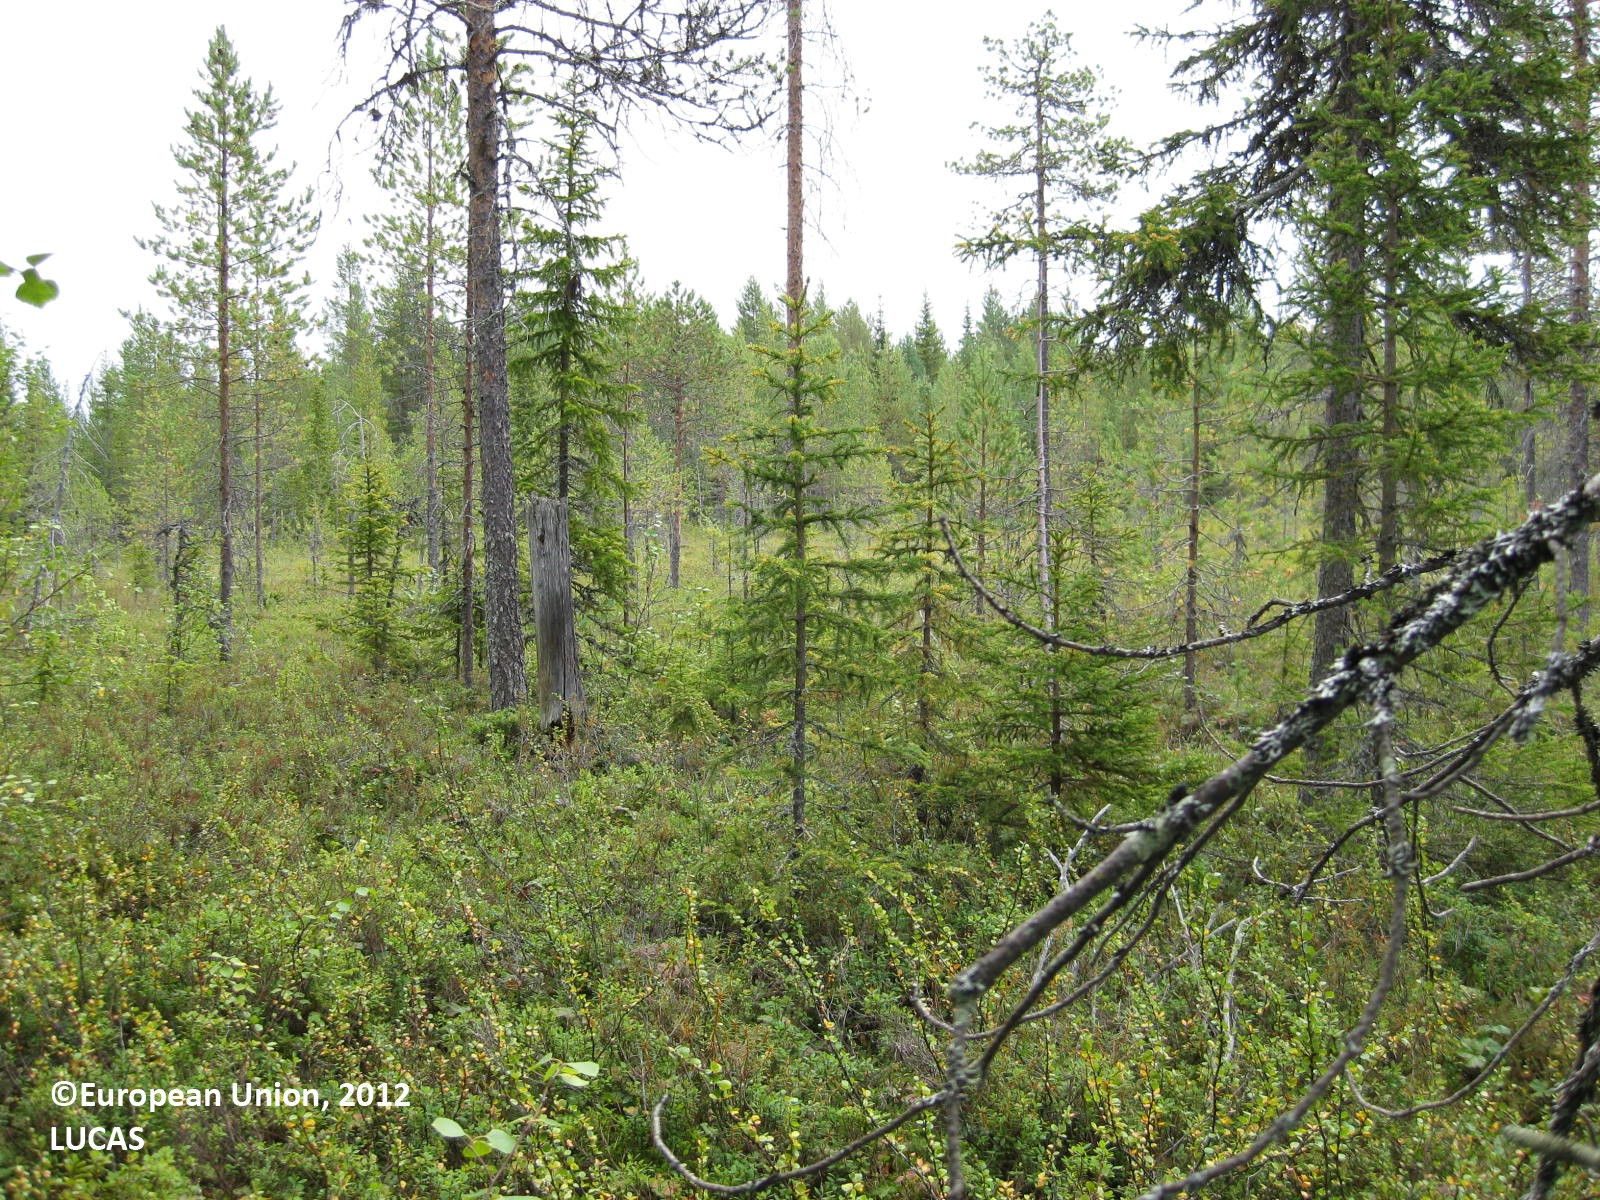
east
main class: Woodland
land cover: Pine dominated mixed woodland
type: boreal forest
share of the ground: > 75 %
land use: Forestry
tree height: > 5 m
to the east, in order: Pine dominated mixed woodland; Pine dominated coniferous woodland; Pine dominated mixed woodland; Pine dominated coniferous woodland; Other mixed woodland
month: August
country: FI
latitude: 66.2542
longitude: 28.7871
